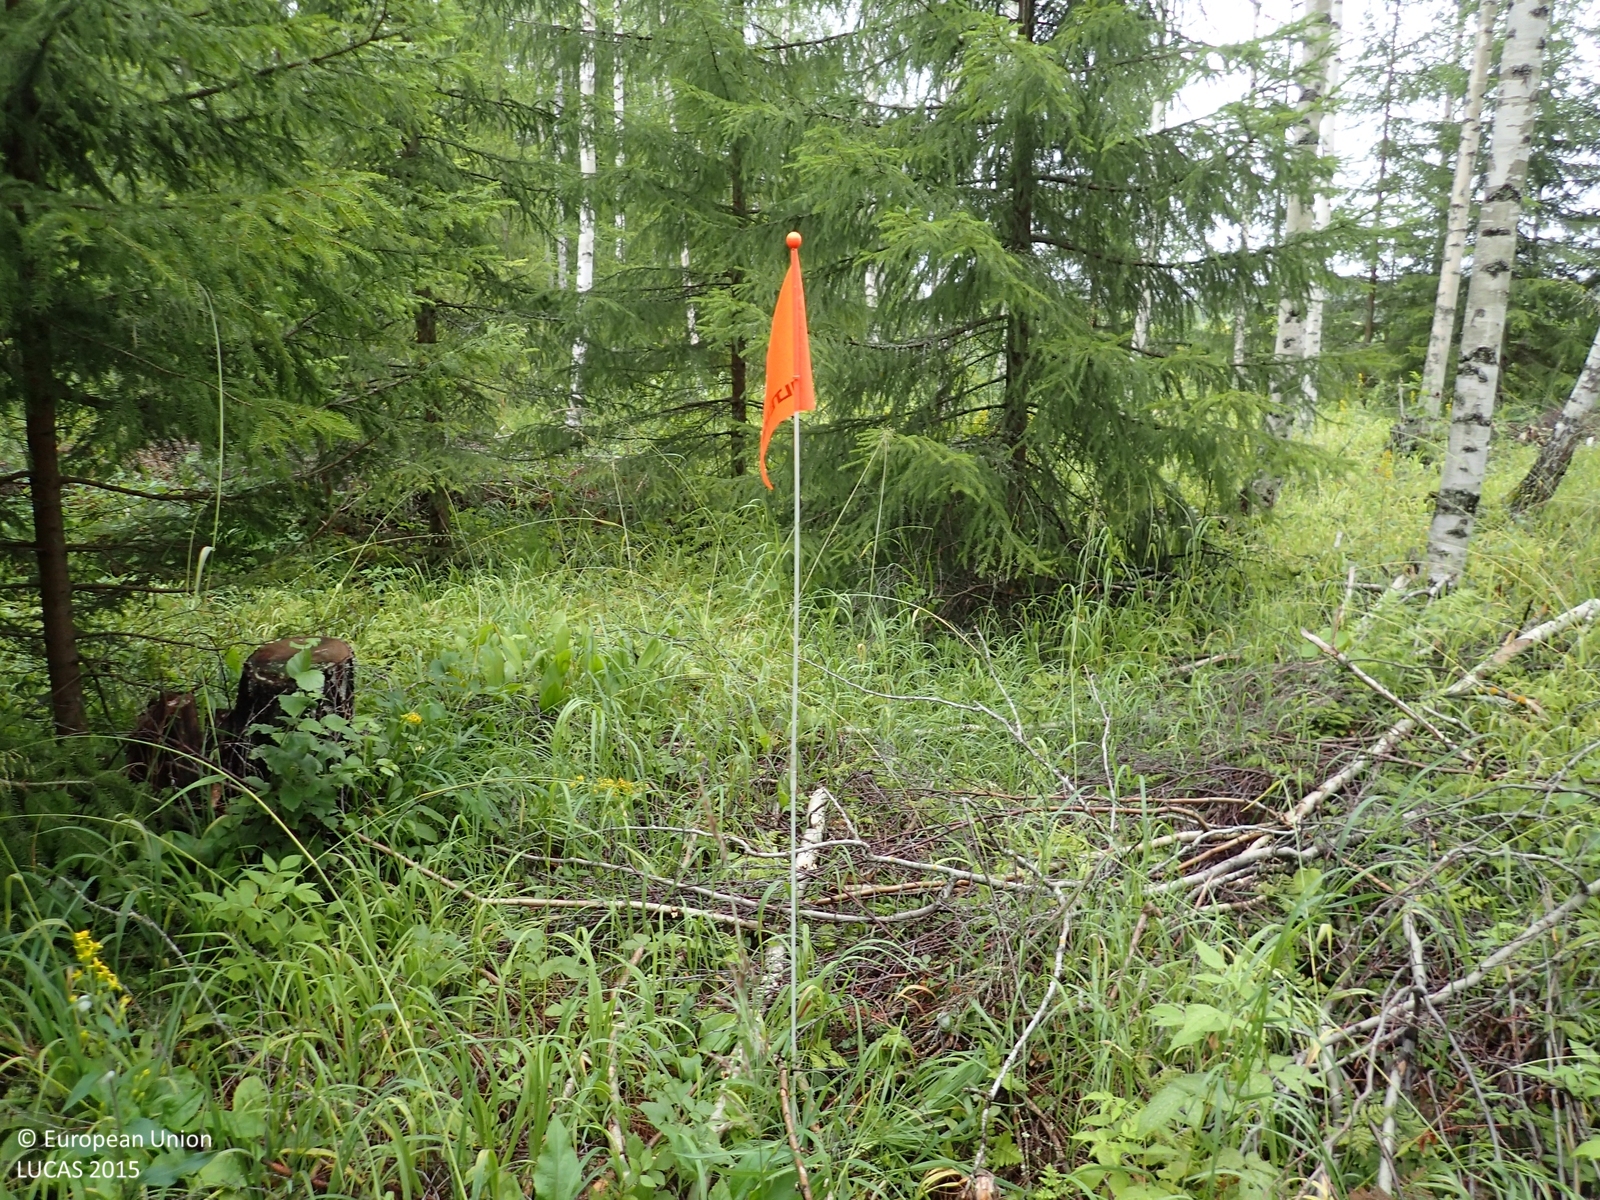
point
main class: Woodland
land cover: Spruce dominated mixed woodland
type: boreal forest
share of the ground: 50 - 75 %
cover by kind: coniferous forest trees 45 %, herbaceous plants 40 %, broadleaved forest trees 15 %
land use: Forestry
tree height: > 5 m
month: July
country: FI
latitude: 62.9550
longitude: 22.6509
